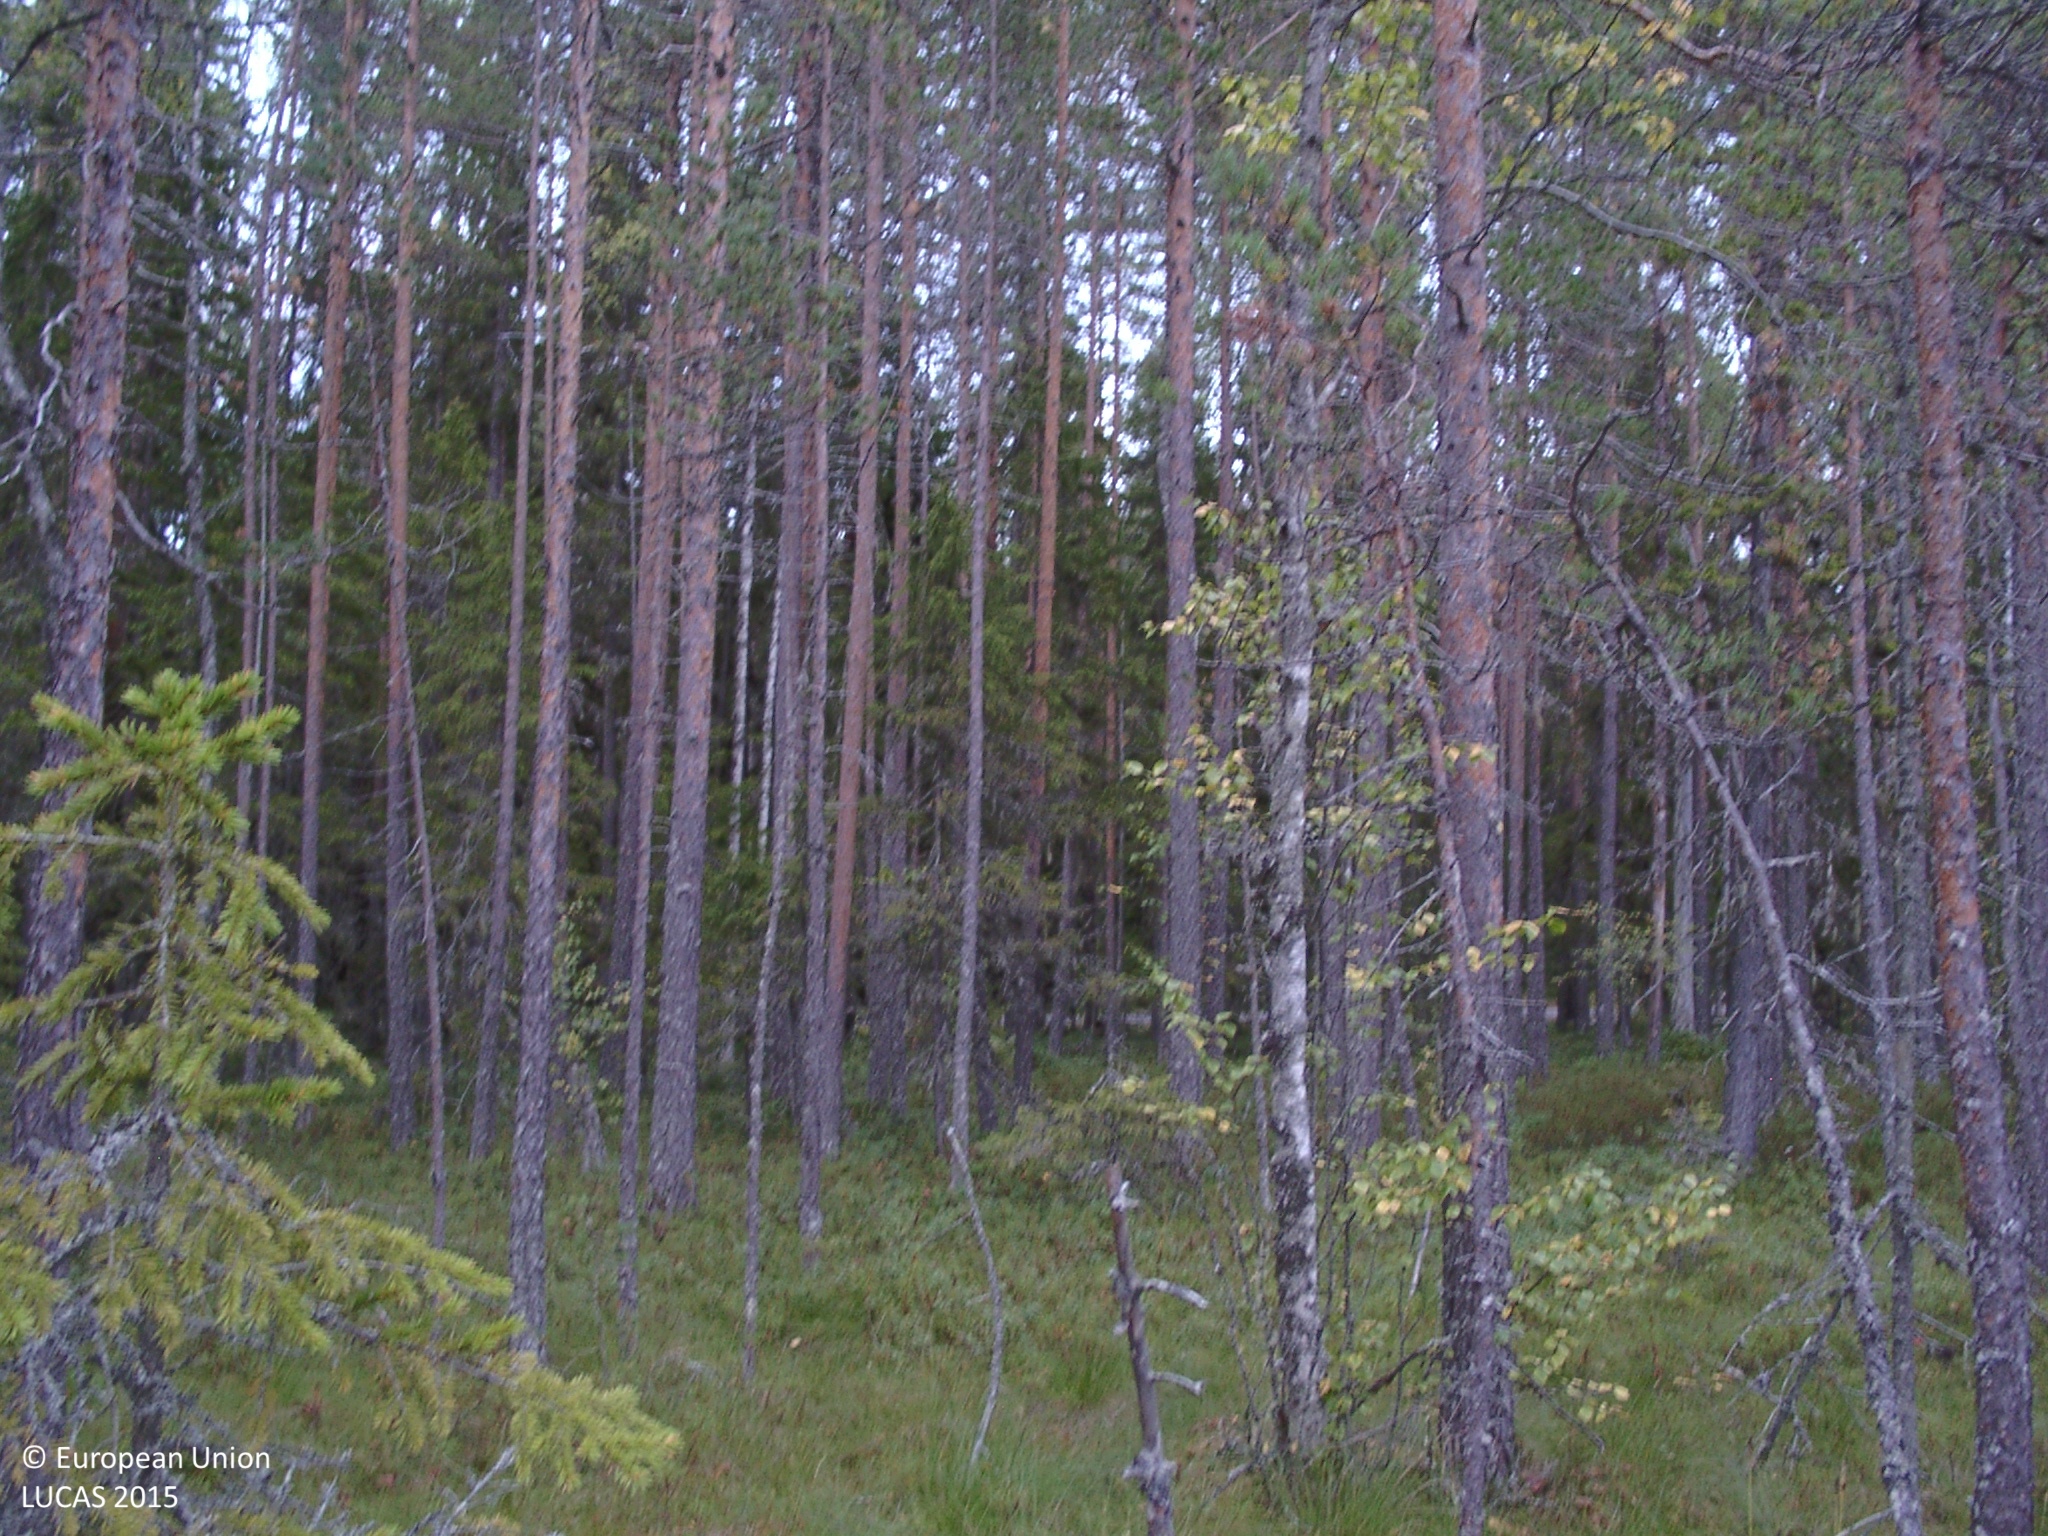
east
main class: Woodland
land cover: Pine dominated coniferous woodland
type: mire and swamp forests
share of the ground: 25 - 50 %
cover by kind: coniferous forest trees 45 %, shrubs 20 %, herbaceous plants 20 %, lichens and mosses 15 %
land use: Amenities, museums, leisure
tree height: > 5 m
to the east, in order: Pine dominated coniferous woodland; Other coniferous woodland; Paved roads, cycling and walking lanes; Grass margins; Other coniferous woodland
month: September
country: FI
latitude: 62.8549
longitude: 25.4910
